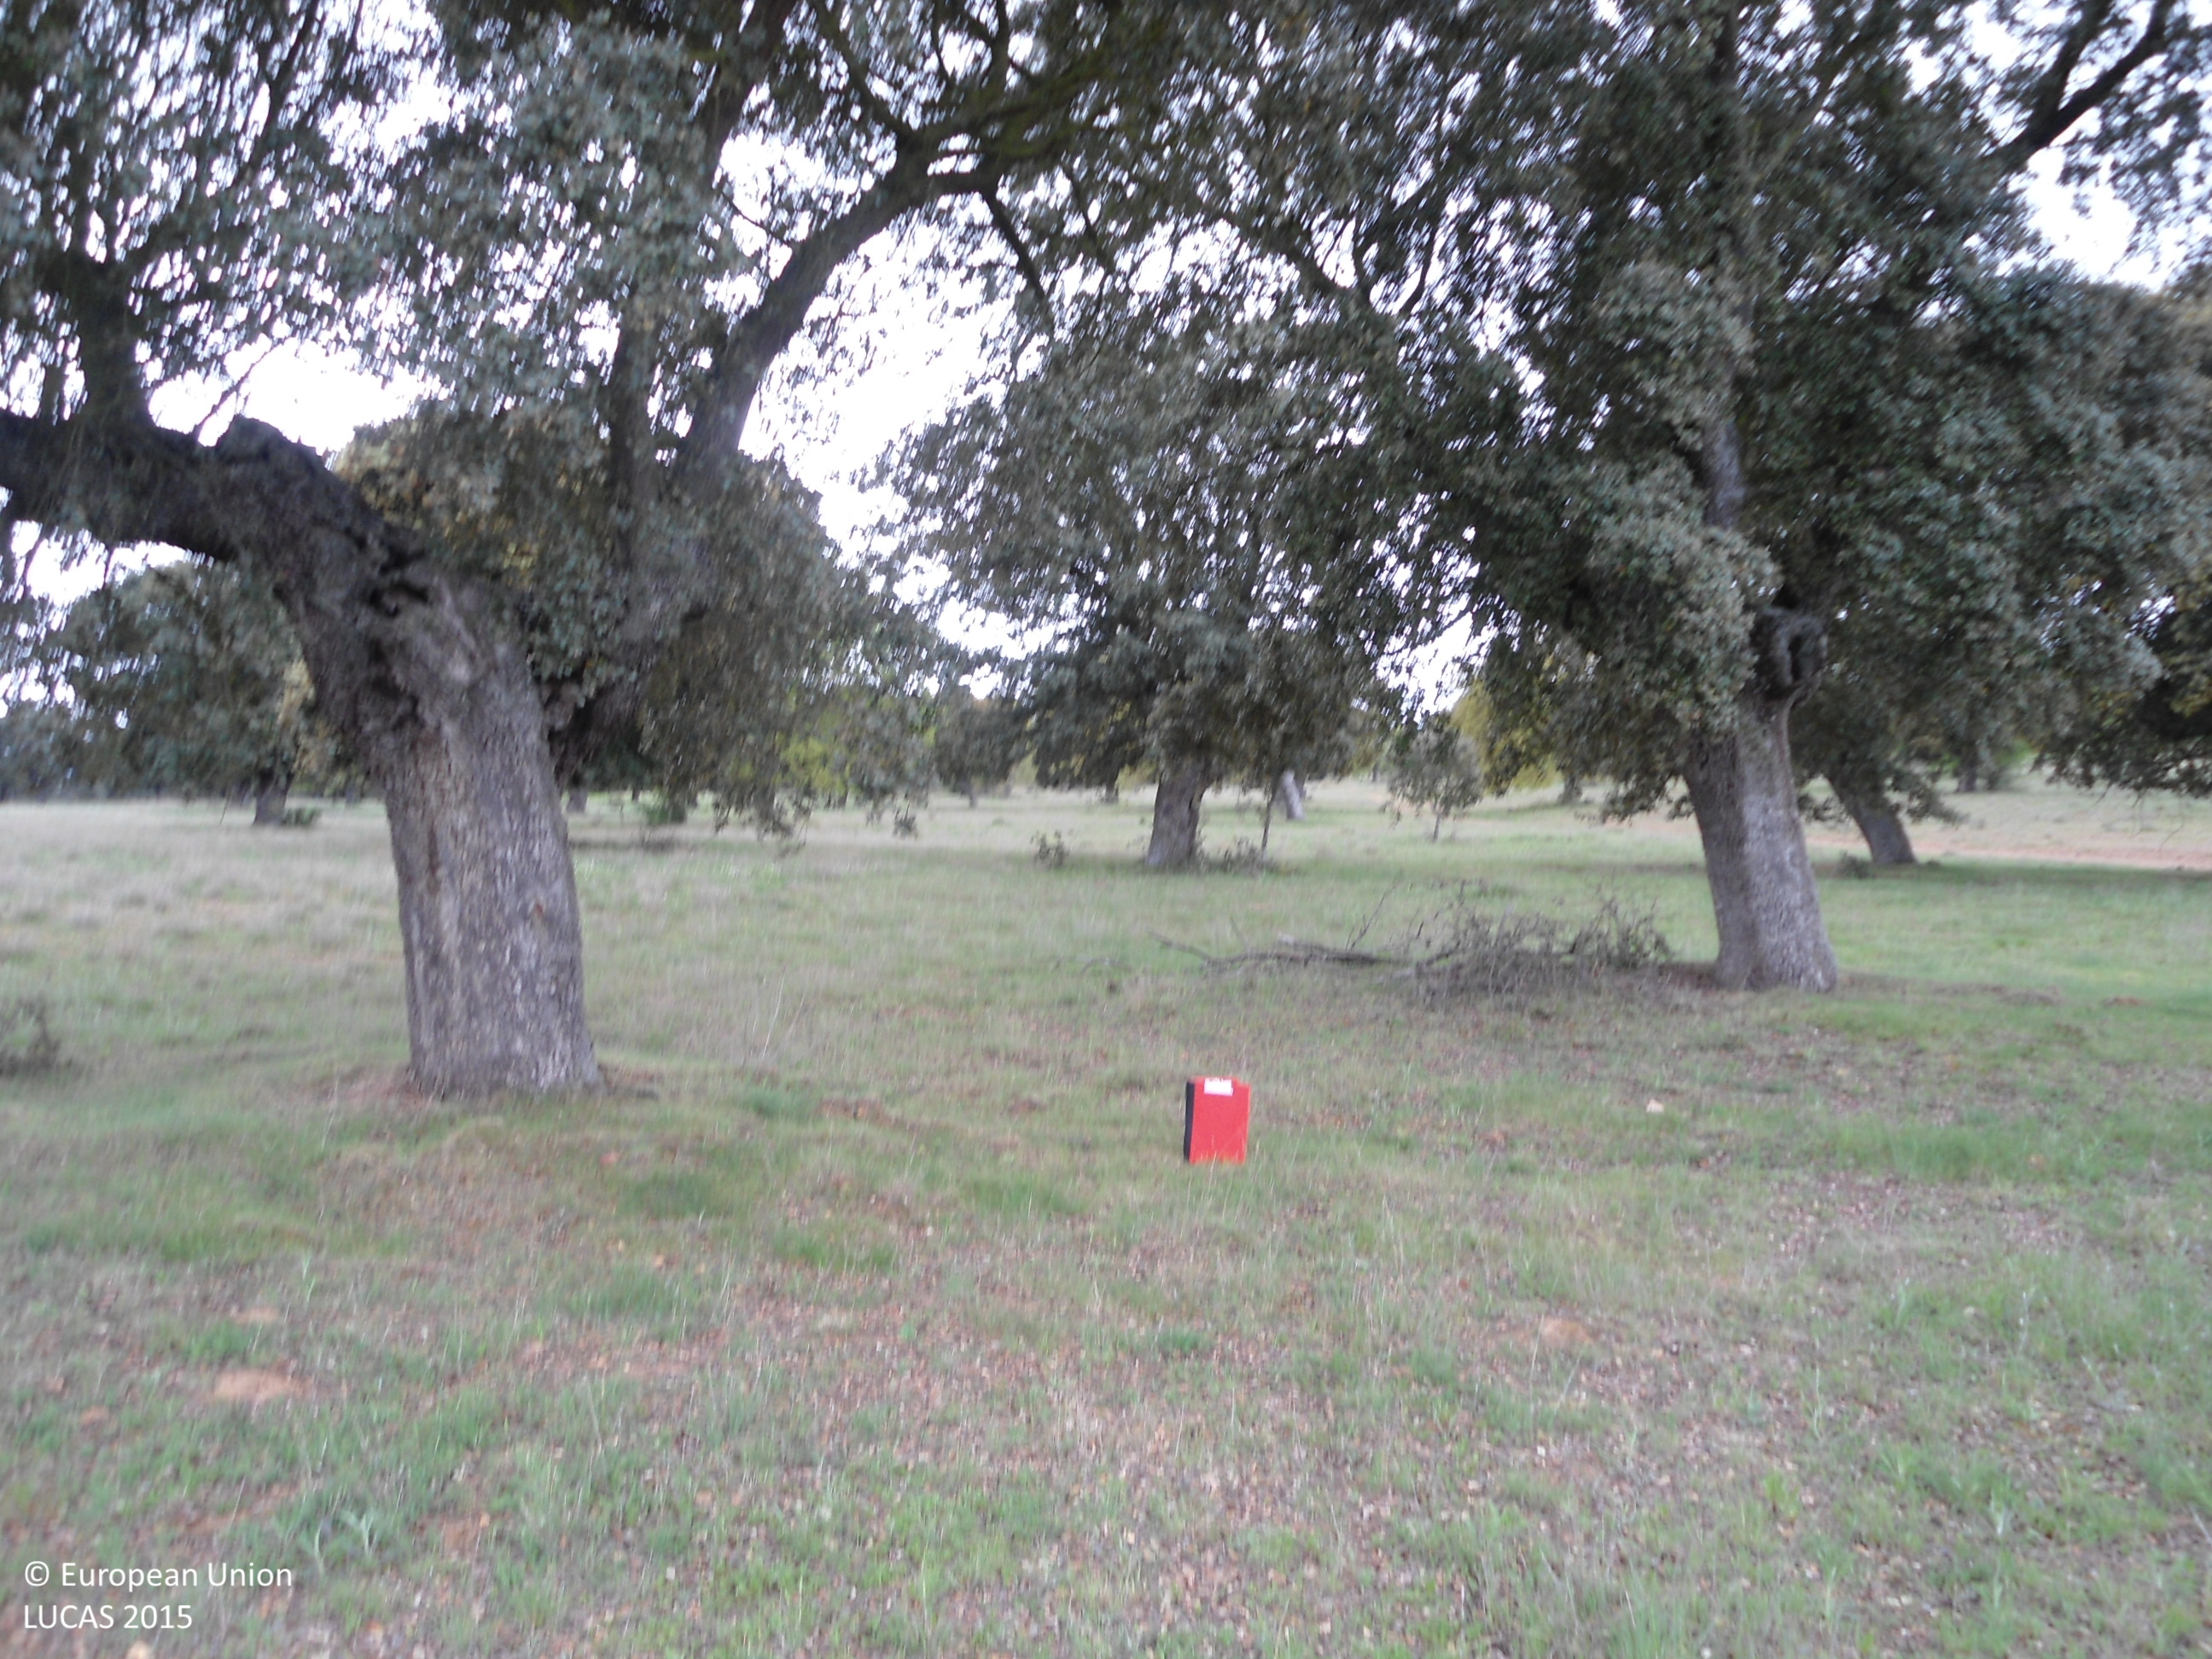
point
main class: Woodland
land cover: Broadleaved woodland
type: broadleaved evergreen forest
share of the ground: 25 - 50 %
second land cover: Grassland without tree/shrub cover
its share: 50 - 75 %
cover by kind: herbaceous plants 55 %, broadleaved forest trees 40 %, shrubs 5 %
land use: Forestry
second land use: Agriculture (excluding fallow land and kitchen gardens)
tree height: > 5 m
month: May
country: ES
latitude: 41.8114
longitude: -5.8989
